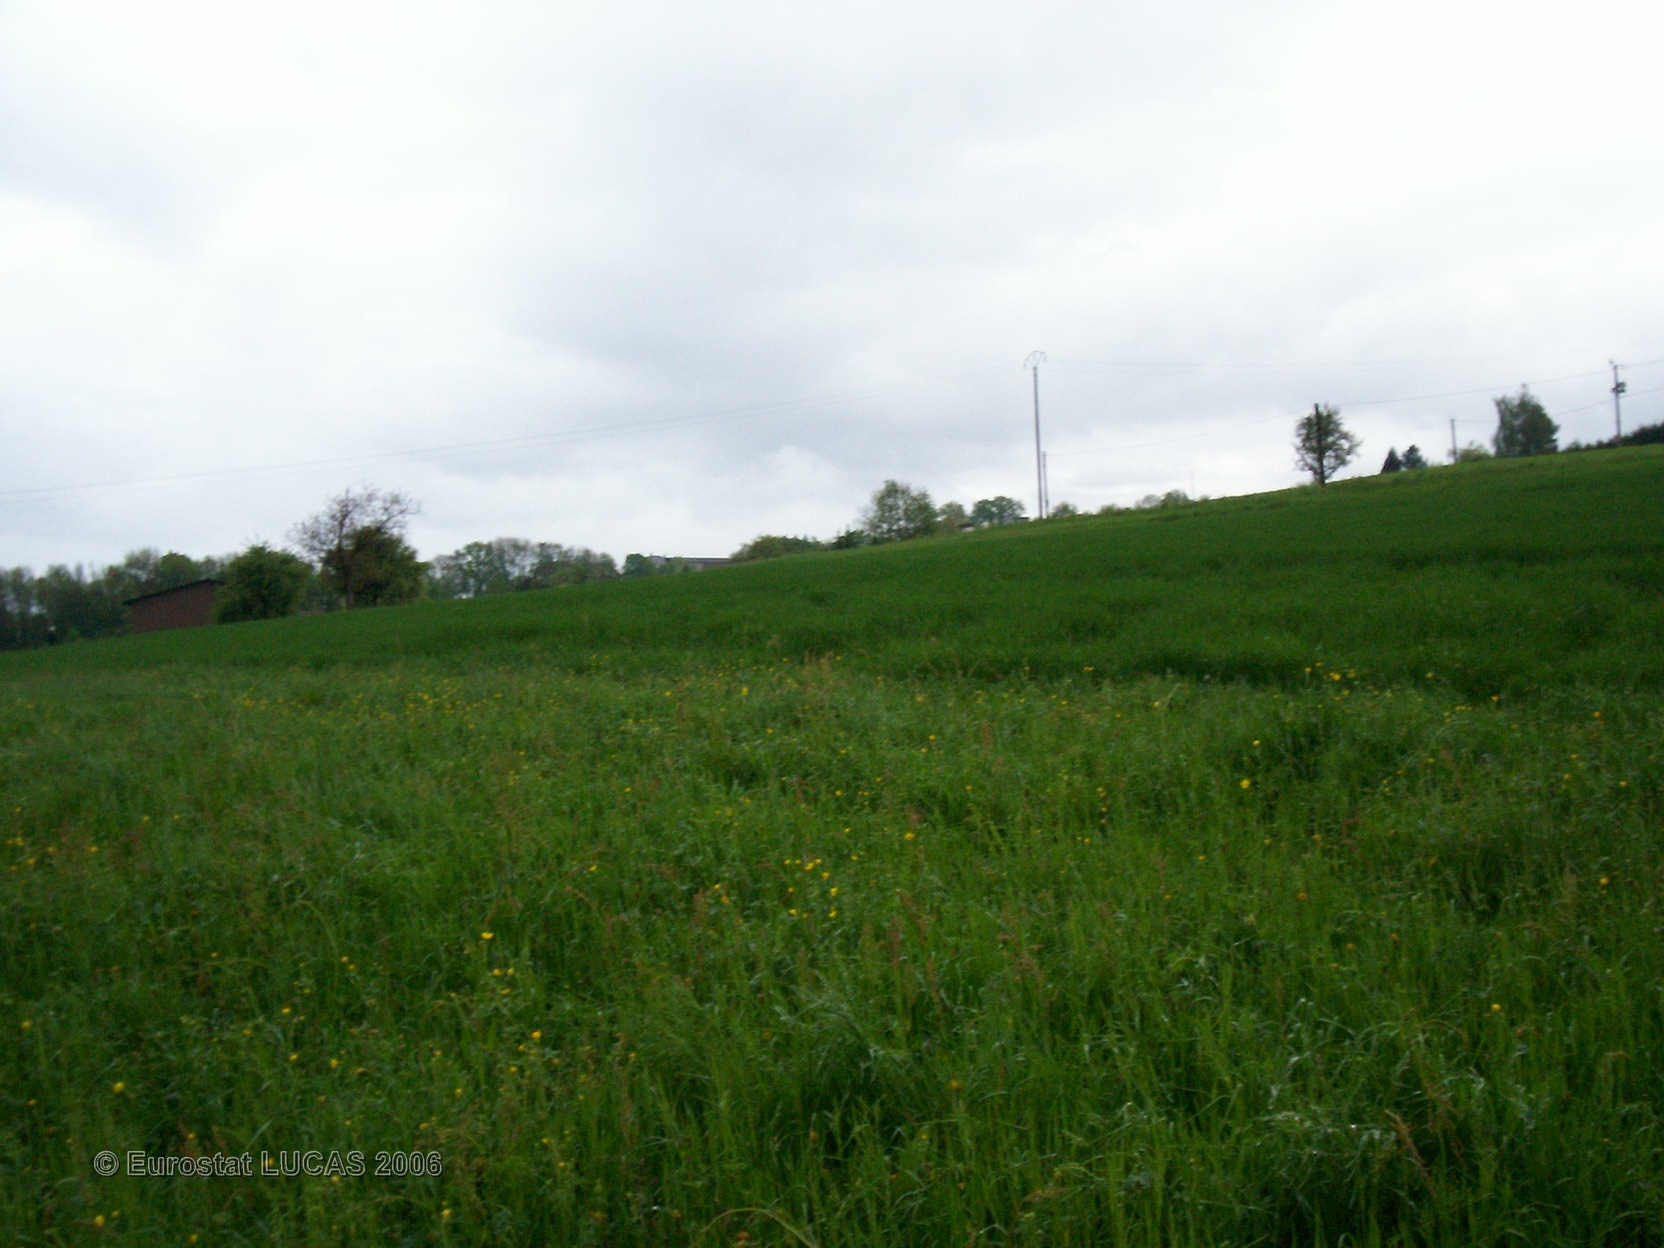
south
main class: Grassland
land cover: Grassland without tree/shrub cover
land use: Agriculture (excluding fallow land and kitchen gardens)
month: May
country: FR
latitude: 45.9922
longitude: 6.1177
